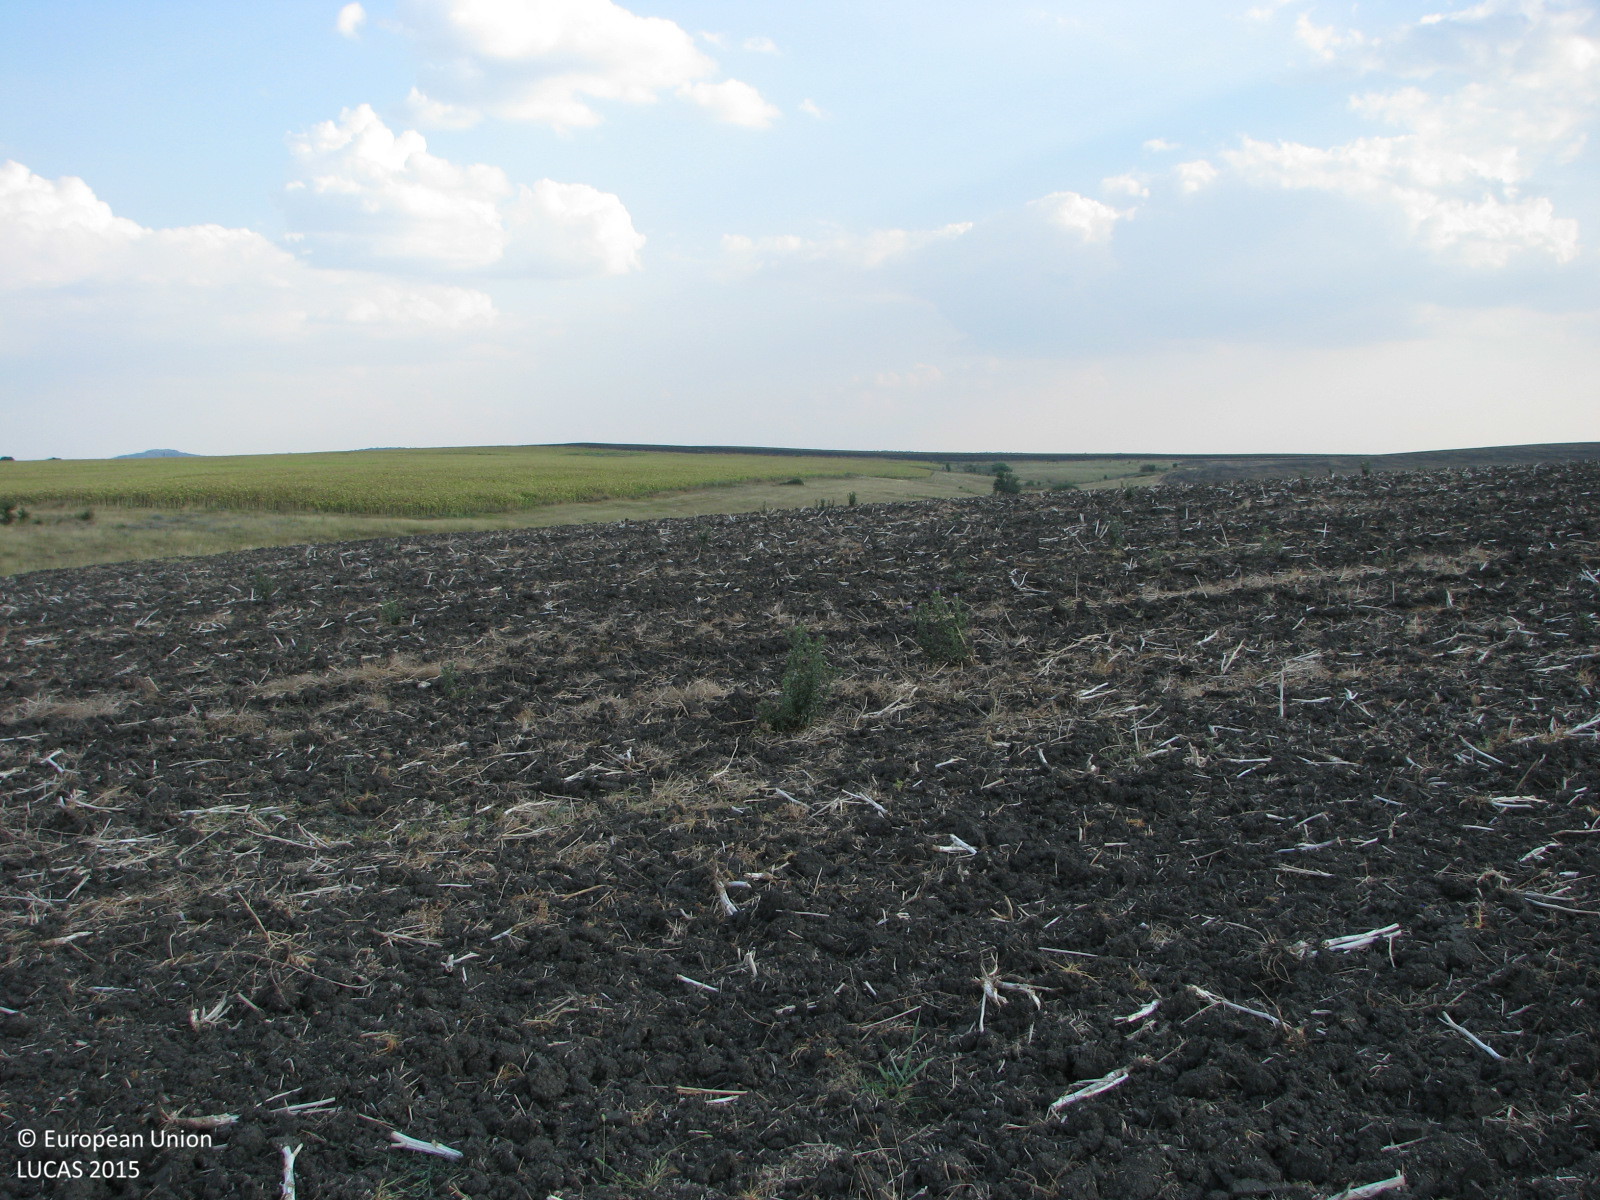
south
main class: Cropland
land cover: Other non-permanent industrial crops
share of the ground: < 10 %
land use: Agriculture (excluding fallow land and kitchen gardens)
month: August
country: BG
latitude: 42.1618
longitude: 26.7854
